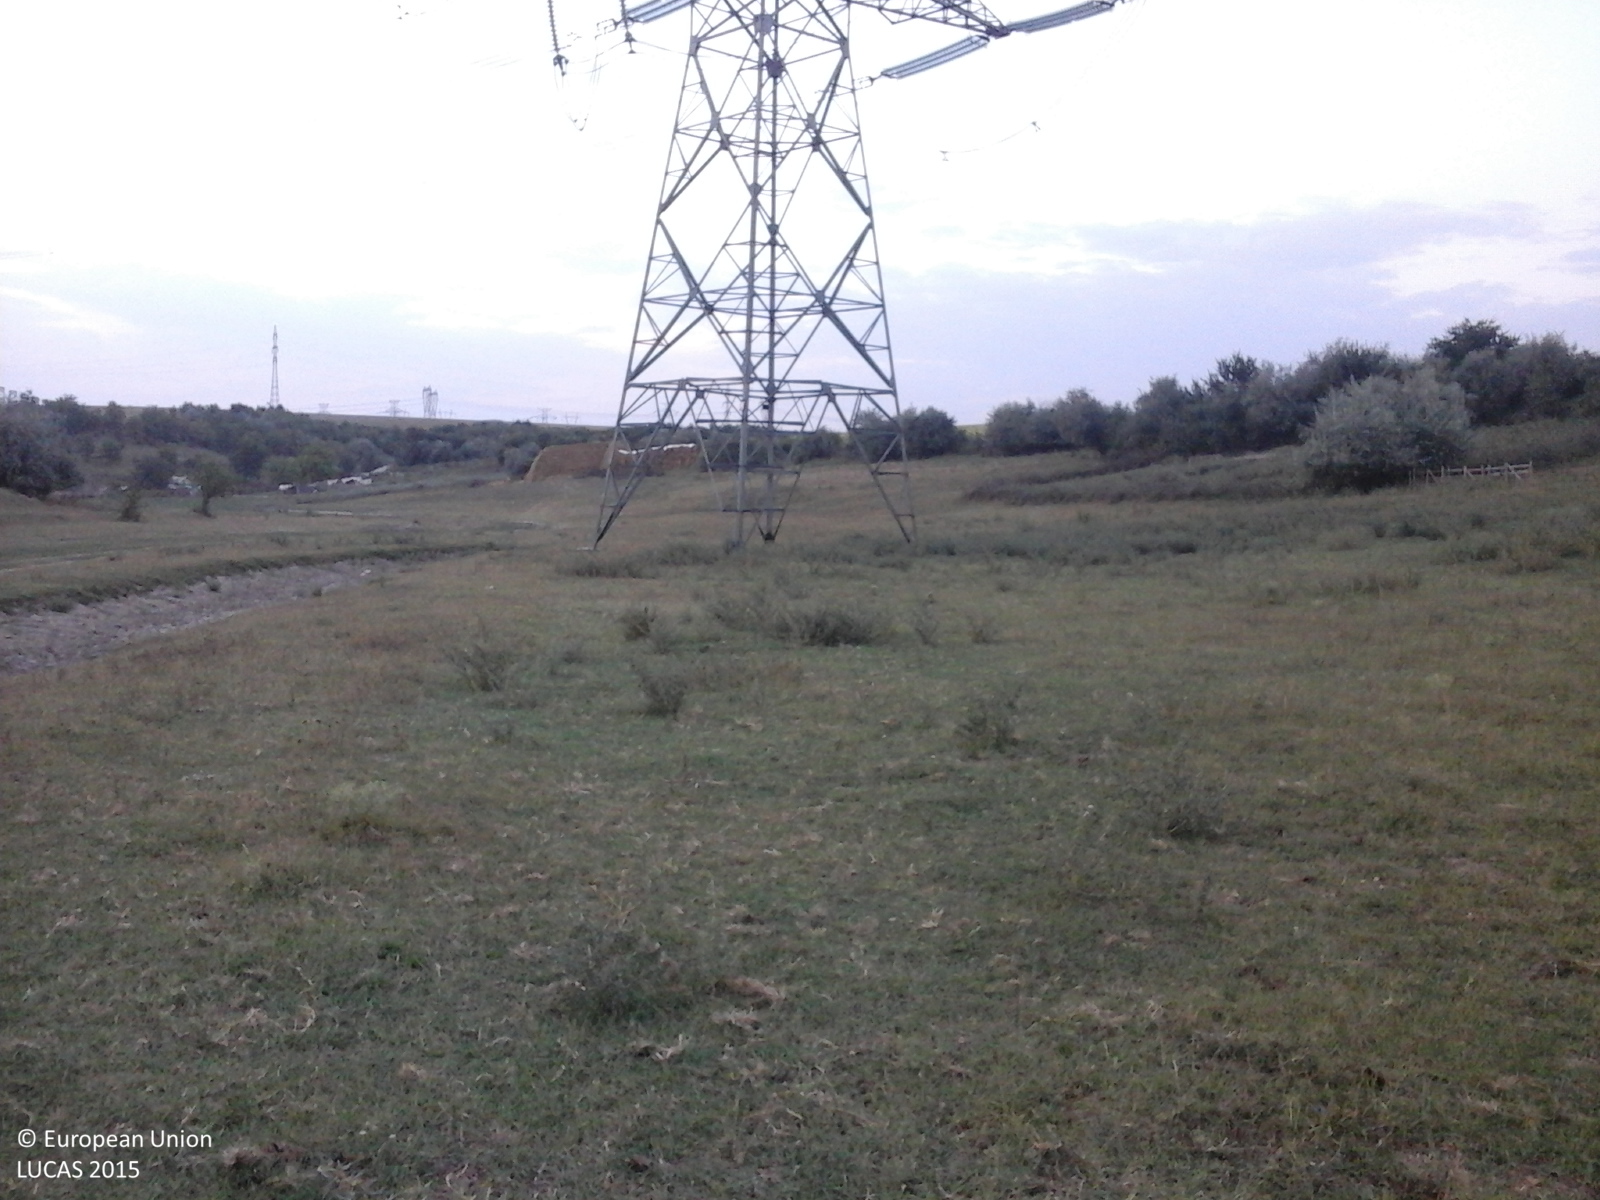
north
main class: Grassland
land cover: Grassland without tree/shrub cover
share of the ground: > 75 %
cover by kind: herbaceous plants 100 %
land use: Agriculture (excluding fallow land and kitchen gardens)
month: August
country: RO
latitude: 44.3152
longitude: 28.0740
